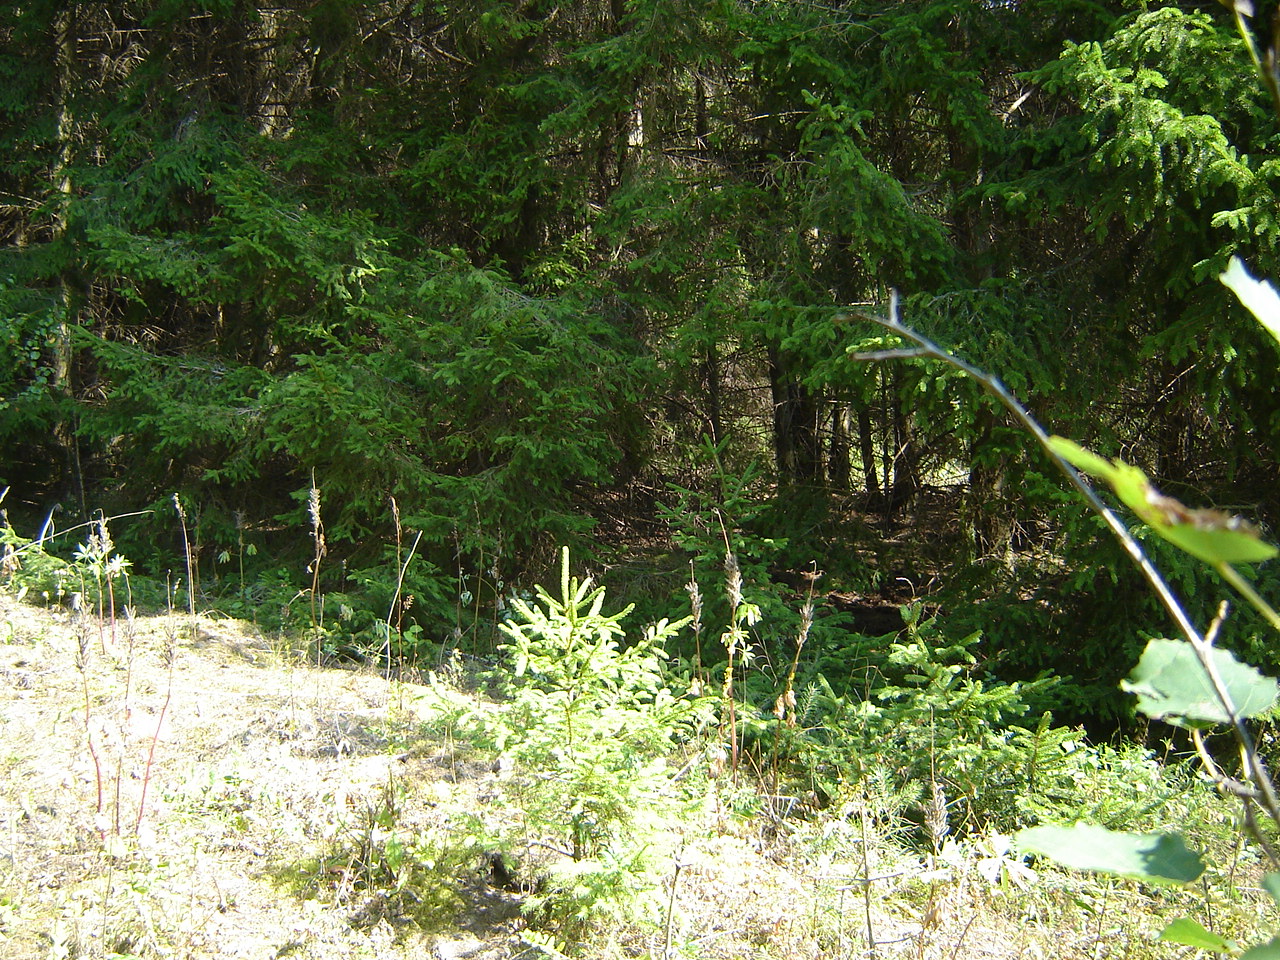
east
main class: Woodland
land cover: Broadleaved woodland
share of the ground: > 75 %
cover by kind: broadleaved forest trees 85 %, herbaceous plants 15 %
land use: Forestry
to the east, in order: Broadleaved woodland; Spruce dominated coniferous woodland; Spruce dominated mixed woodland; Other mixed woodland; Broadleaved woodland
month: August
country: LT
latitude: 54.6820
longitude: 24.7979
